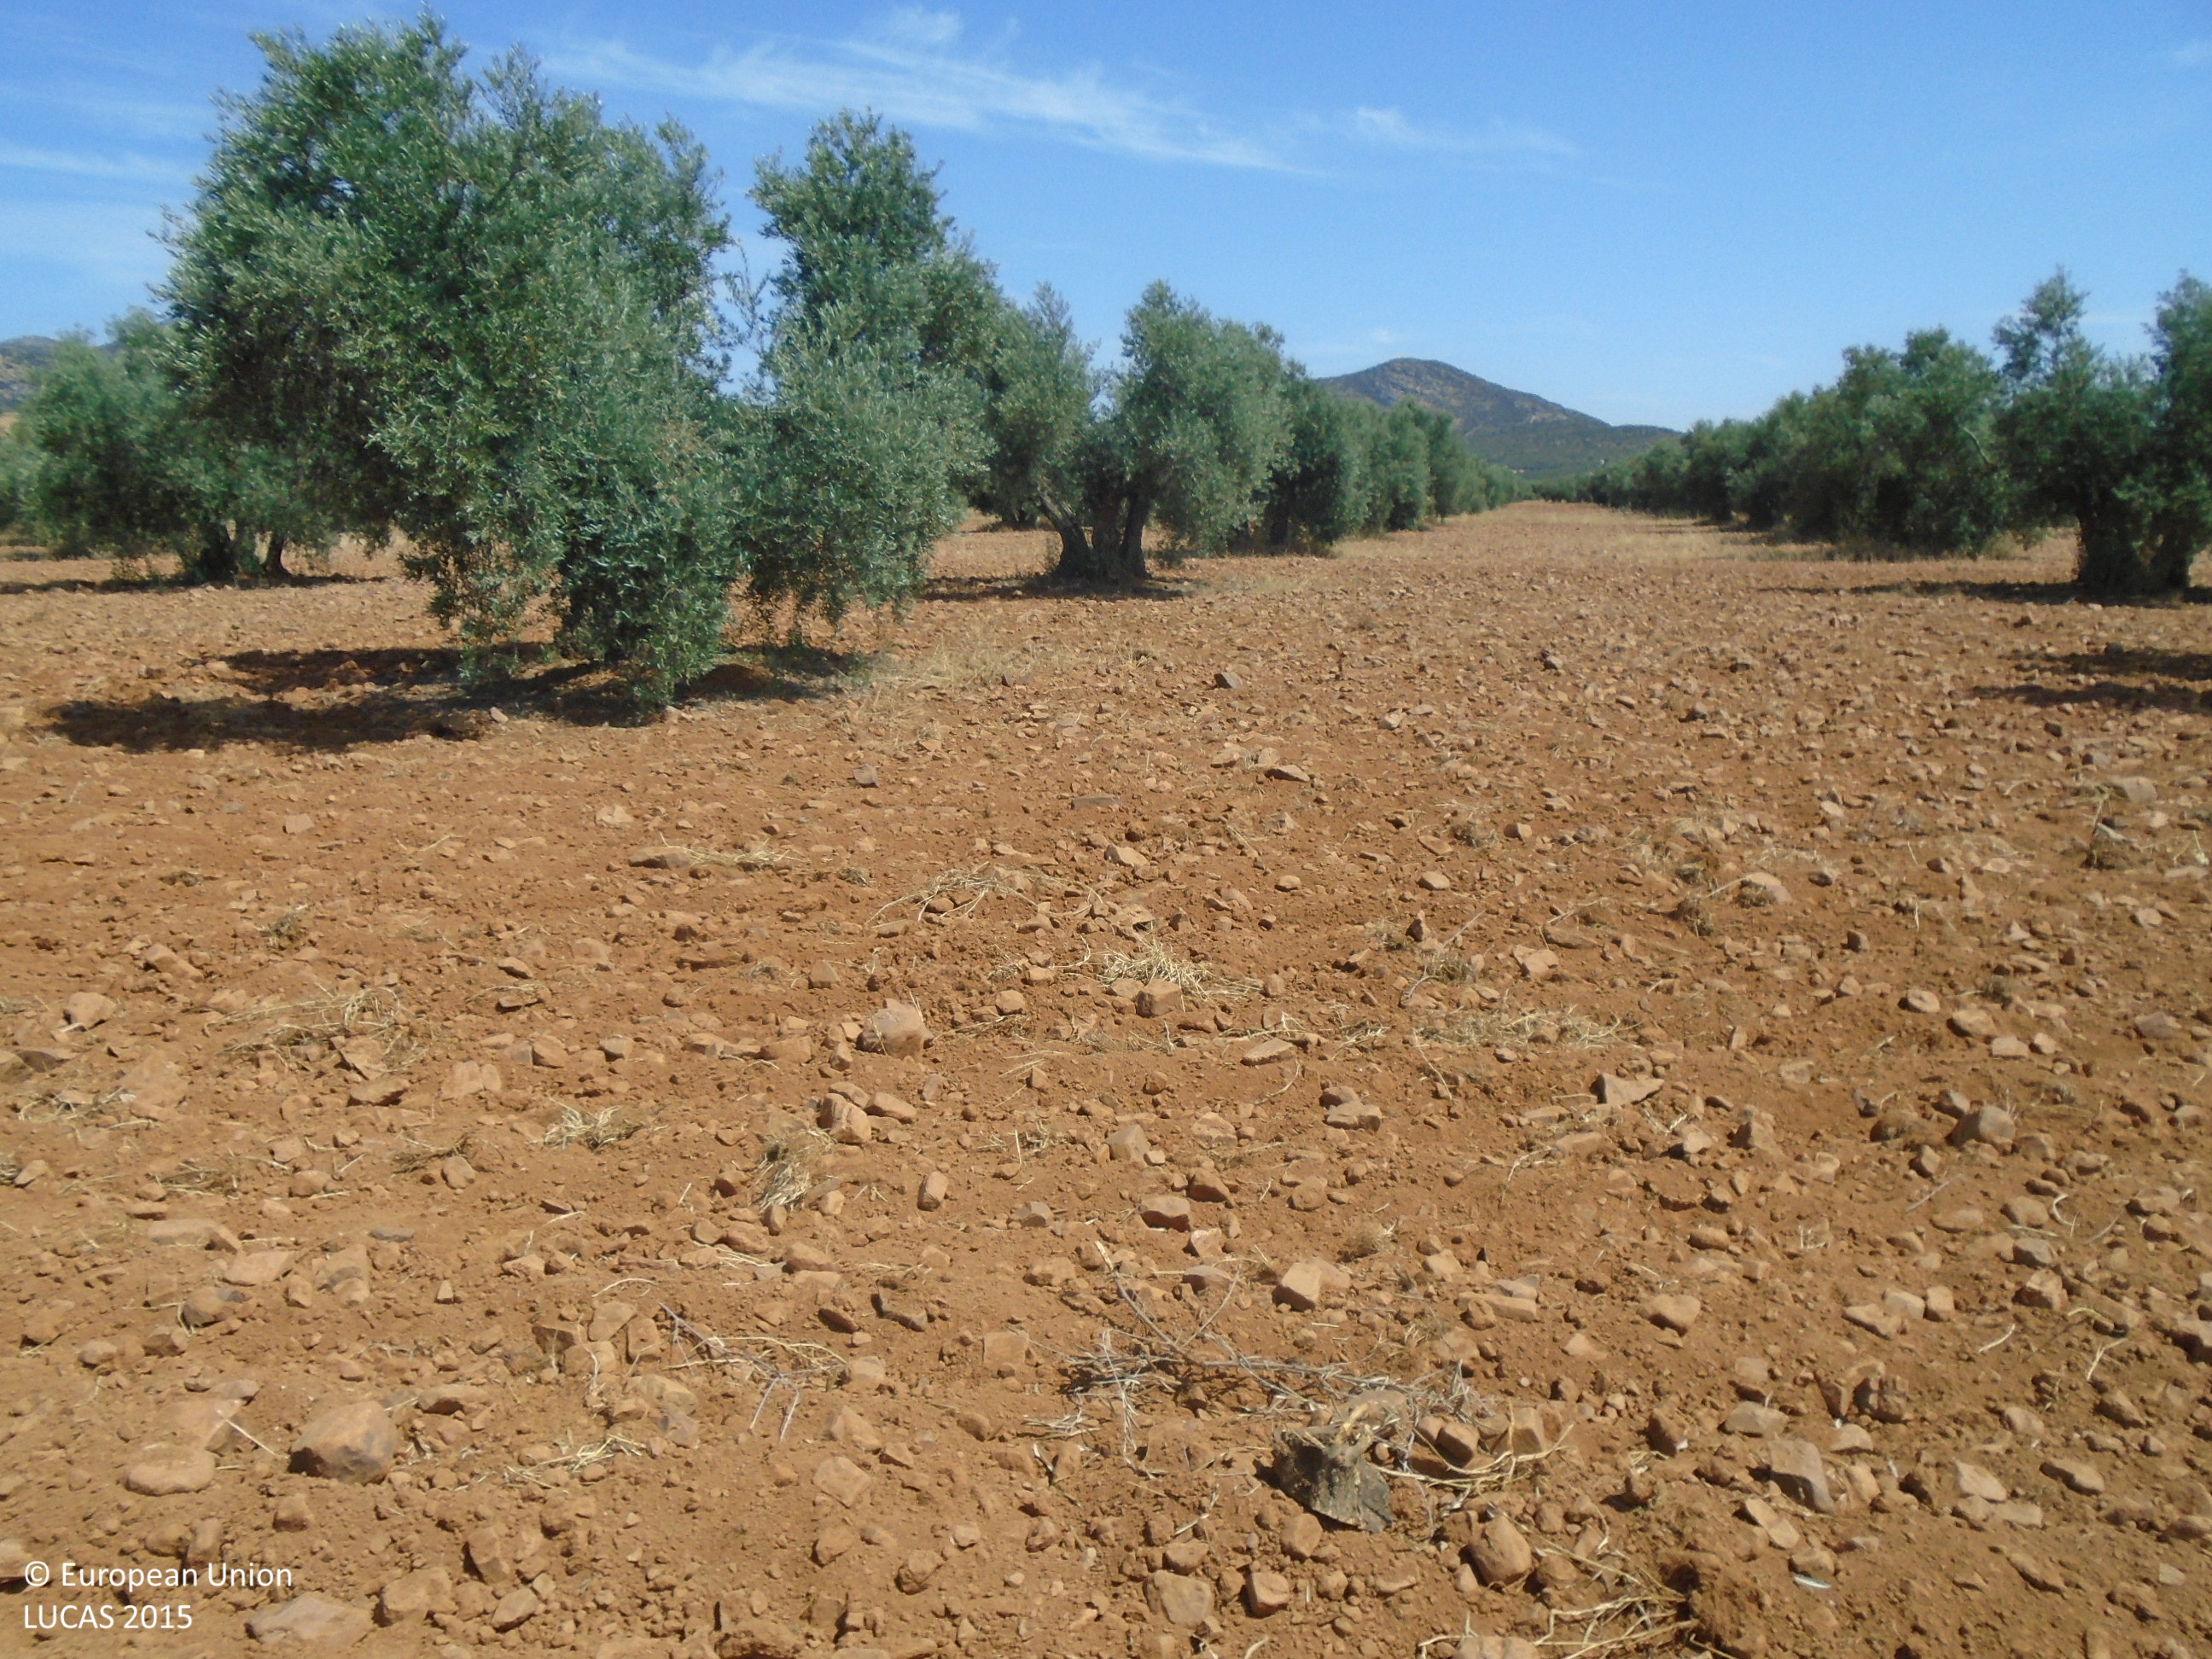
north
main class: Cropland
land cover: Olive groves
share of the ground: 10 - 25 %
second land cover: Other bare soil
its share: > 75 %
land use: Agriculture (excluding fallow land and kitchen gardens)
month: June
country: ES
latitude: 39.2681
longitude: -3.5461
